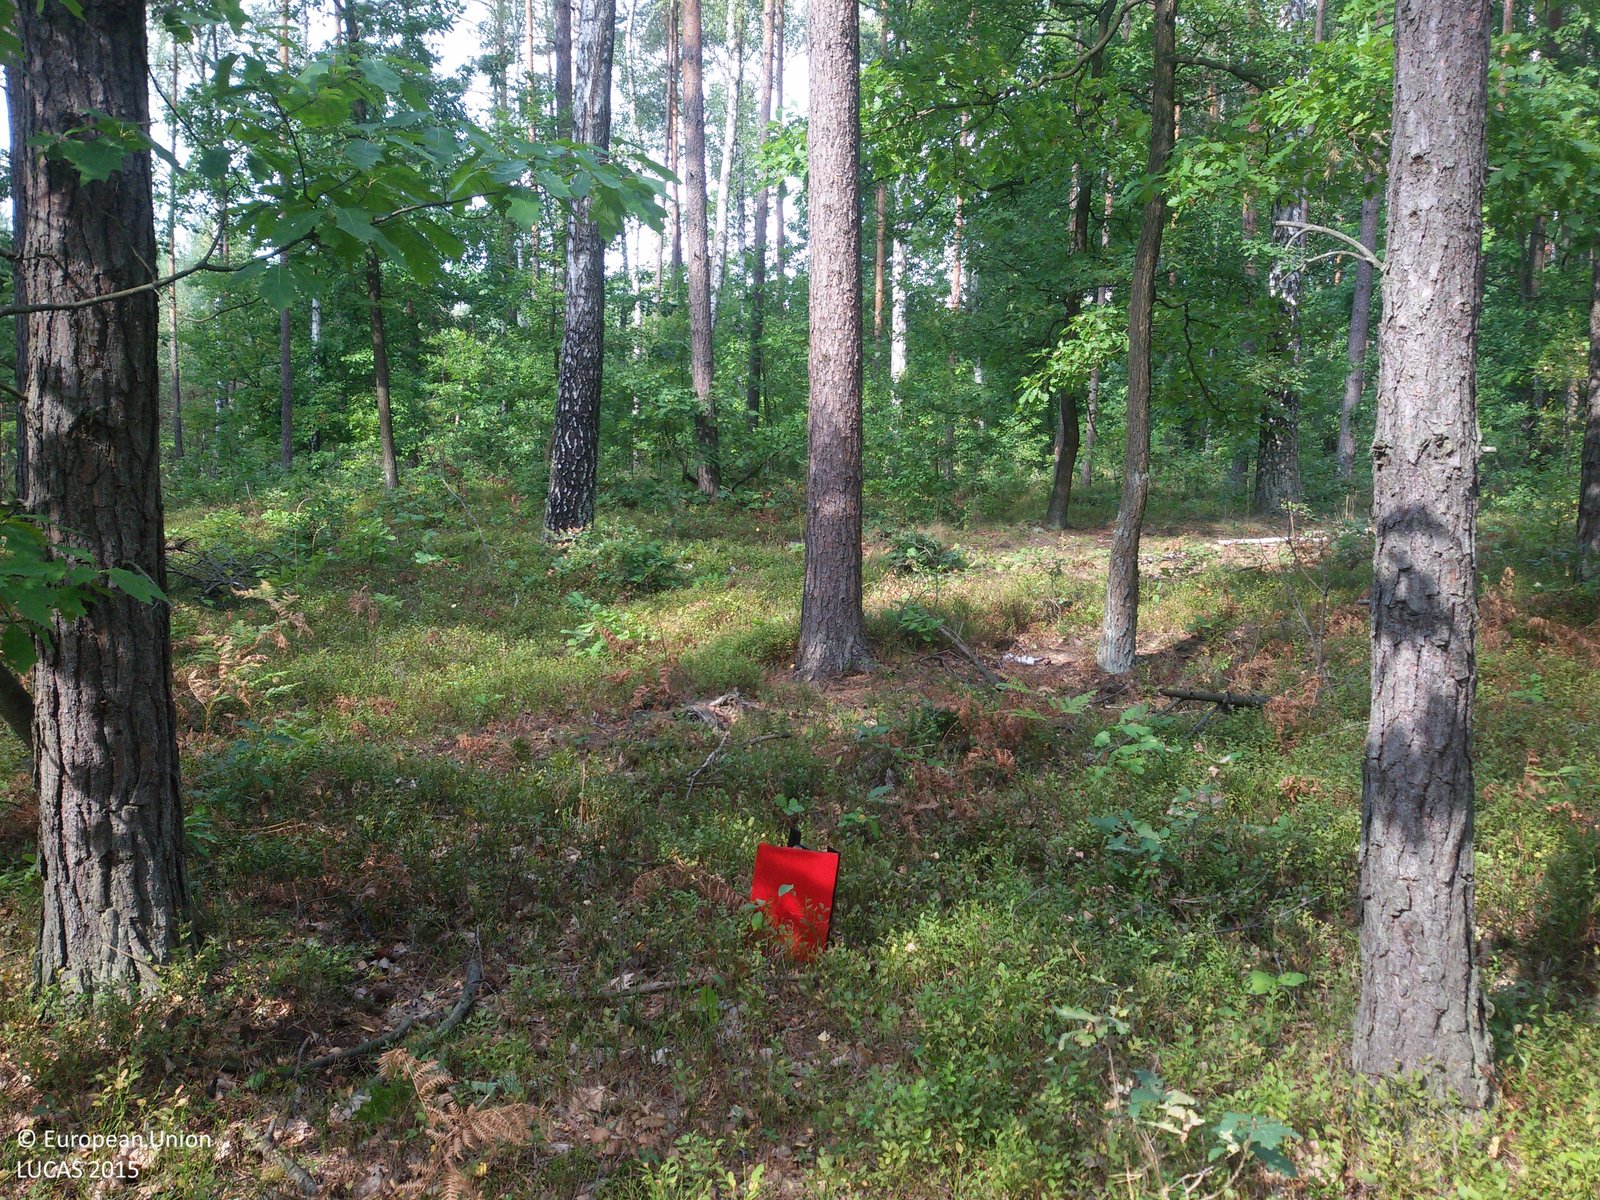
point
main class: Woodland
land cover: Pine dominated mixed woodland
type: hemiboreal forest and nemoral coniferous forest and mixed broadleaved-coniferous forest
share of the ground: > 75 %
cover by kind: coniferous forest trees 60 %, broadleaved forest trees 25 %, herbaceous plants 15 %
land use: Forestry
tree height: > 5 m
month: September
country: PL
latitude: 50.8418
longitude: 18.7551
